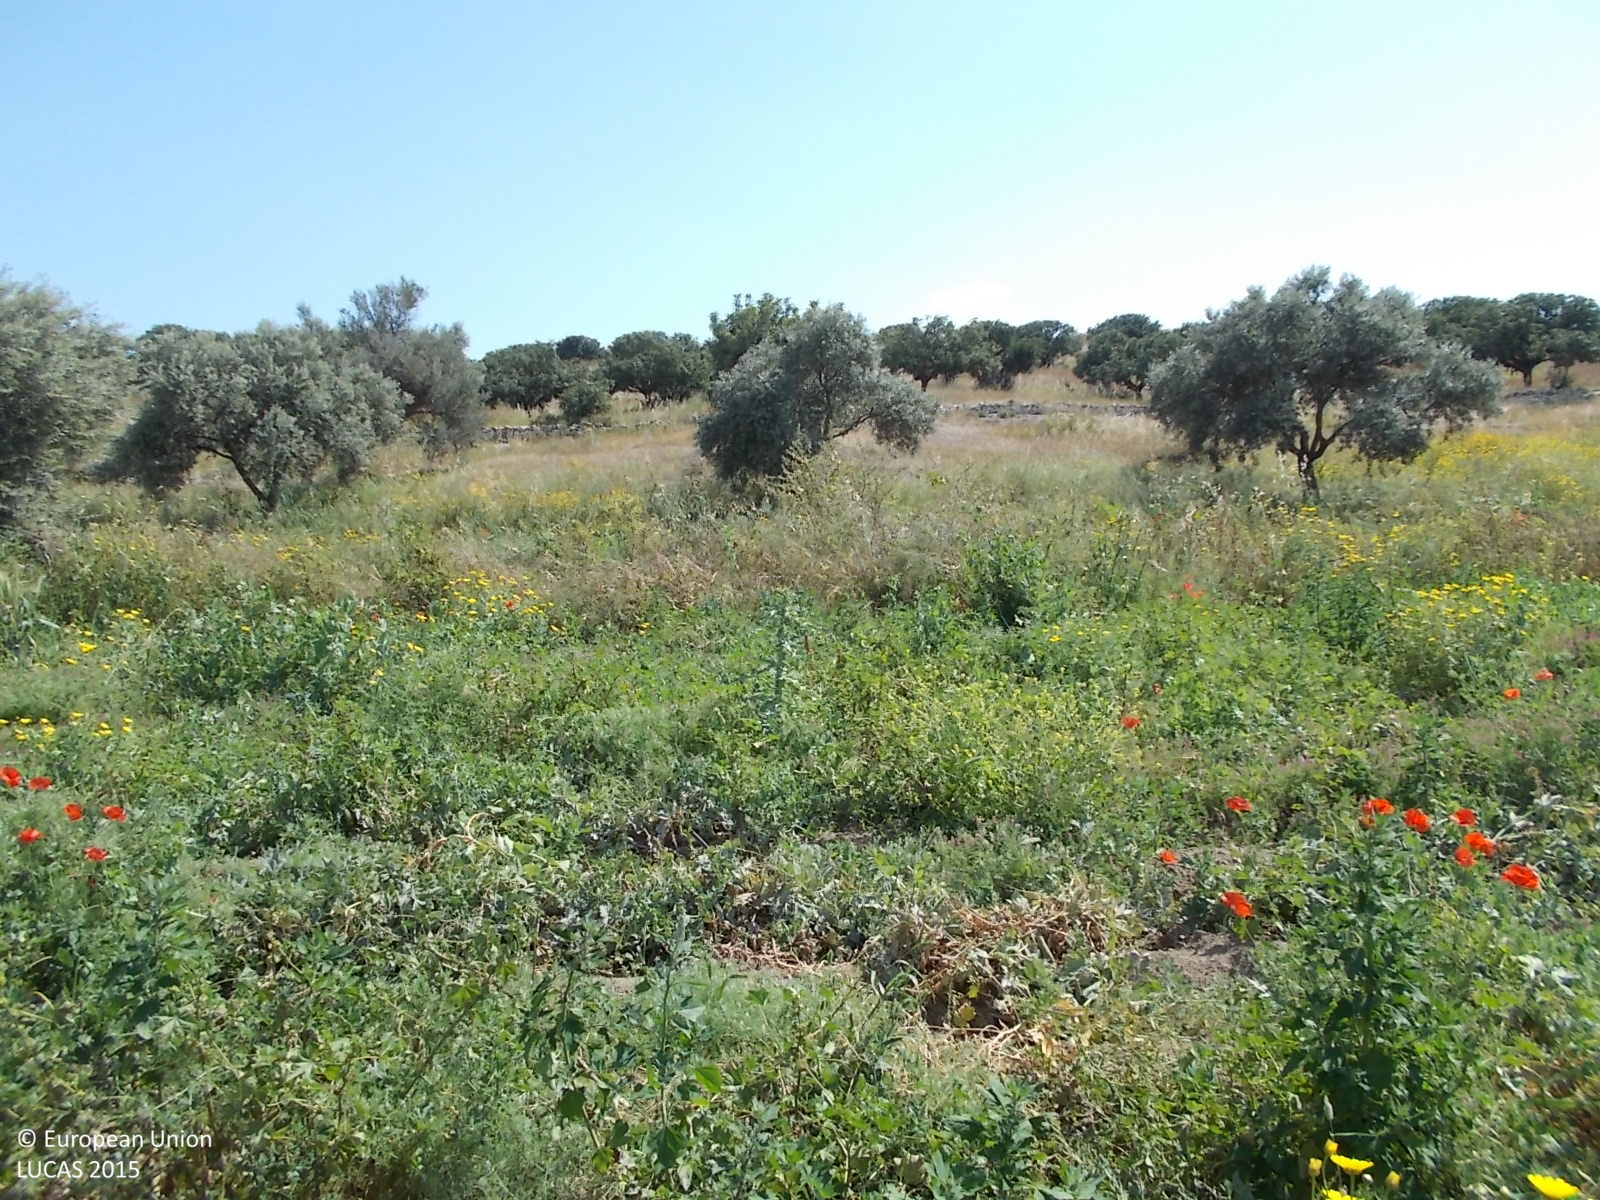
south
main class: Cropland
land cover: Dry pulses
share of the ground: > 75 %
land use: Agriculture (excluding fallow land and kitchen gardens)
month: April
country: CY
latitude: 35.0151
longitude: 33.5954
